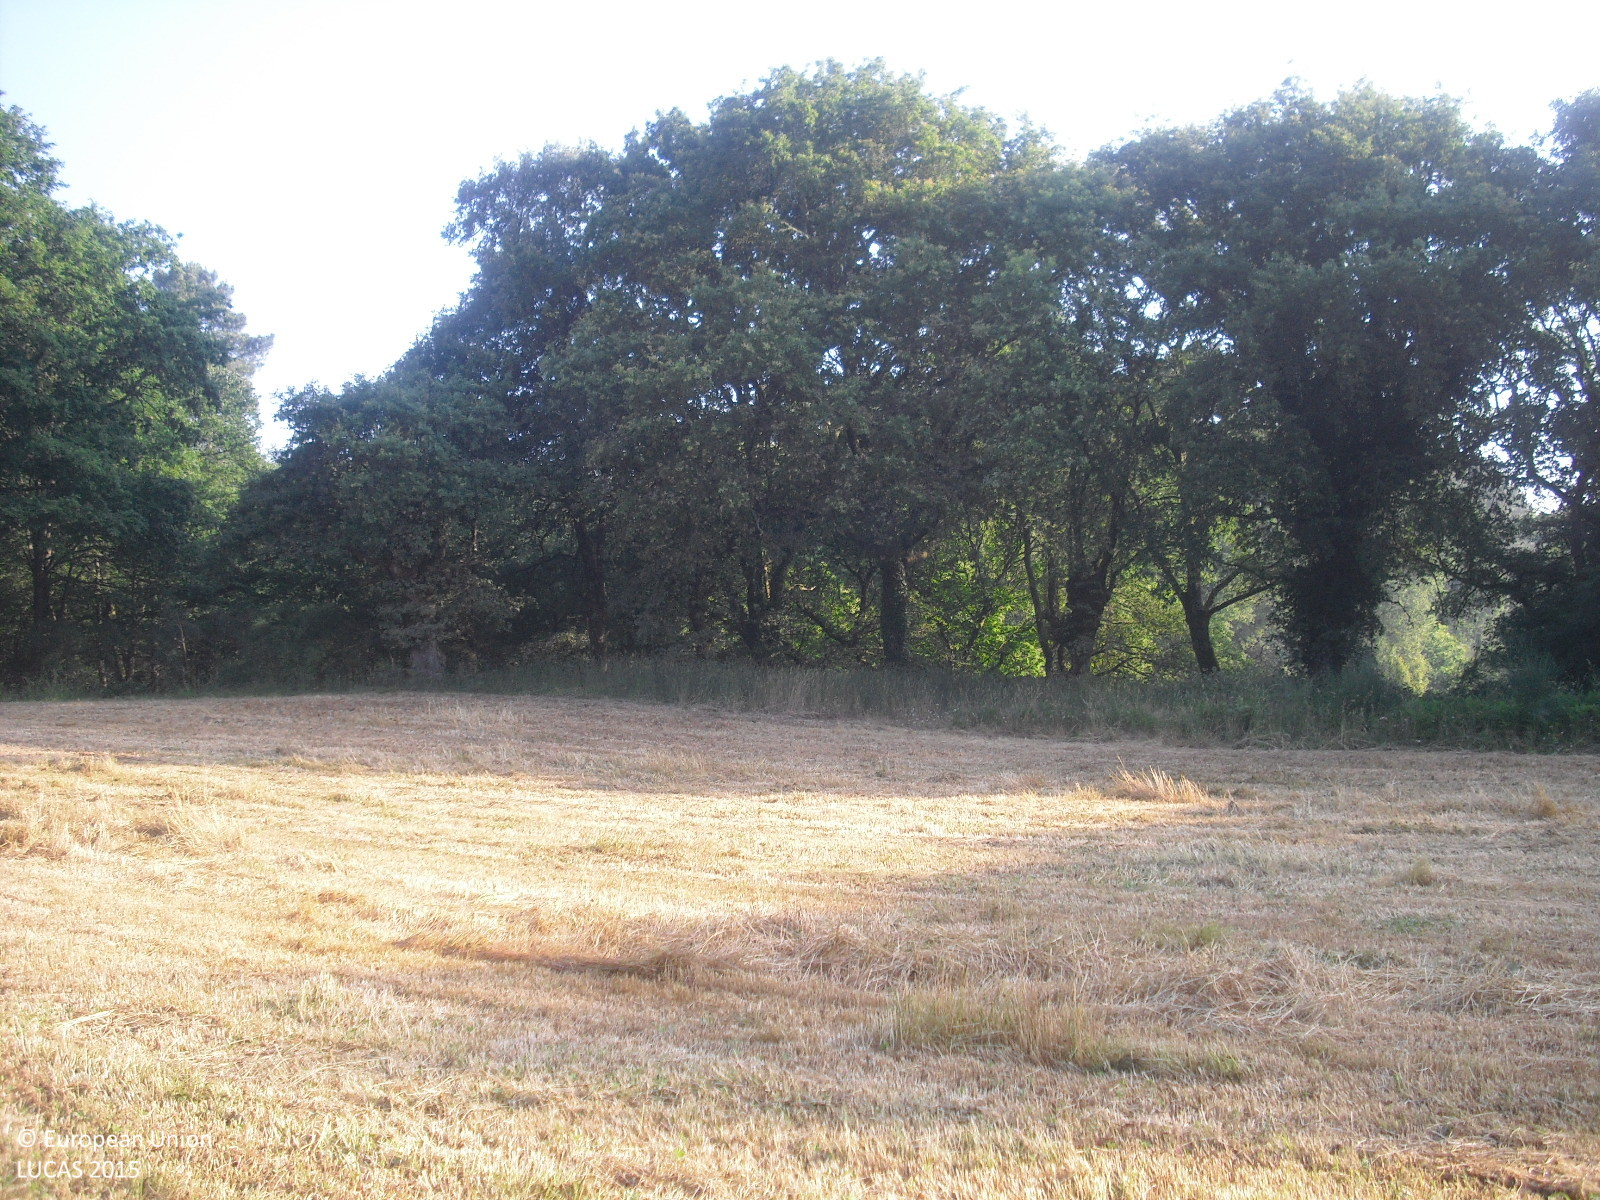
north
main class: Cropland
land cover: Temporary grasslands
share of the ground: > 75 %
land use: Agriculture (excluding fallow land and kitchen gardens)
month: June
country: ES
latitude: 42.5391
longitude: -7.7941
